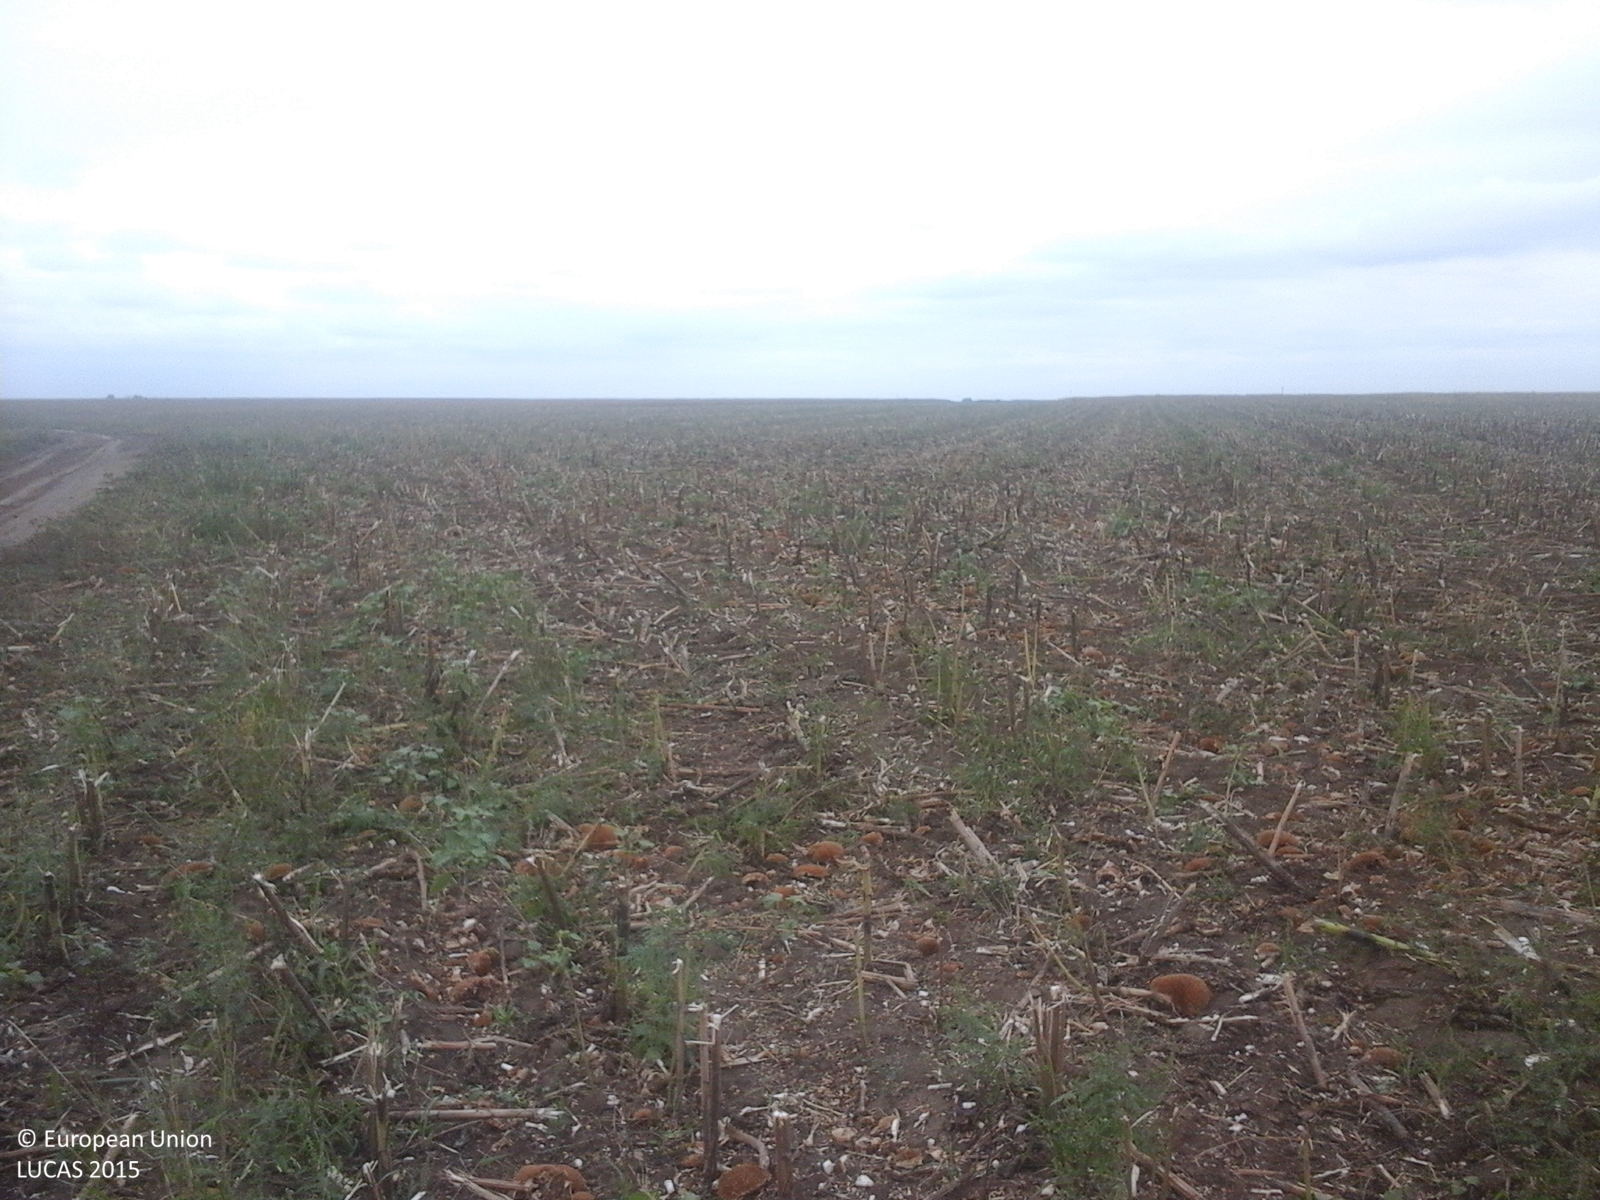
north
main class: Cropland
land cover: Sunflower
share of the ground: < 10 %
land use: Agriculture (excluding fallow land and kitchen gardens)
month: September
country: RO
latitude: 47.3497
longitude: 21.9755
